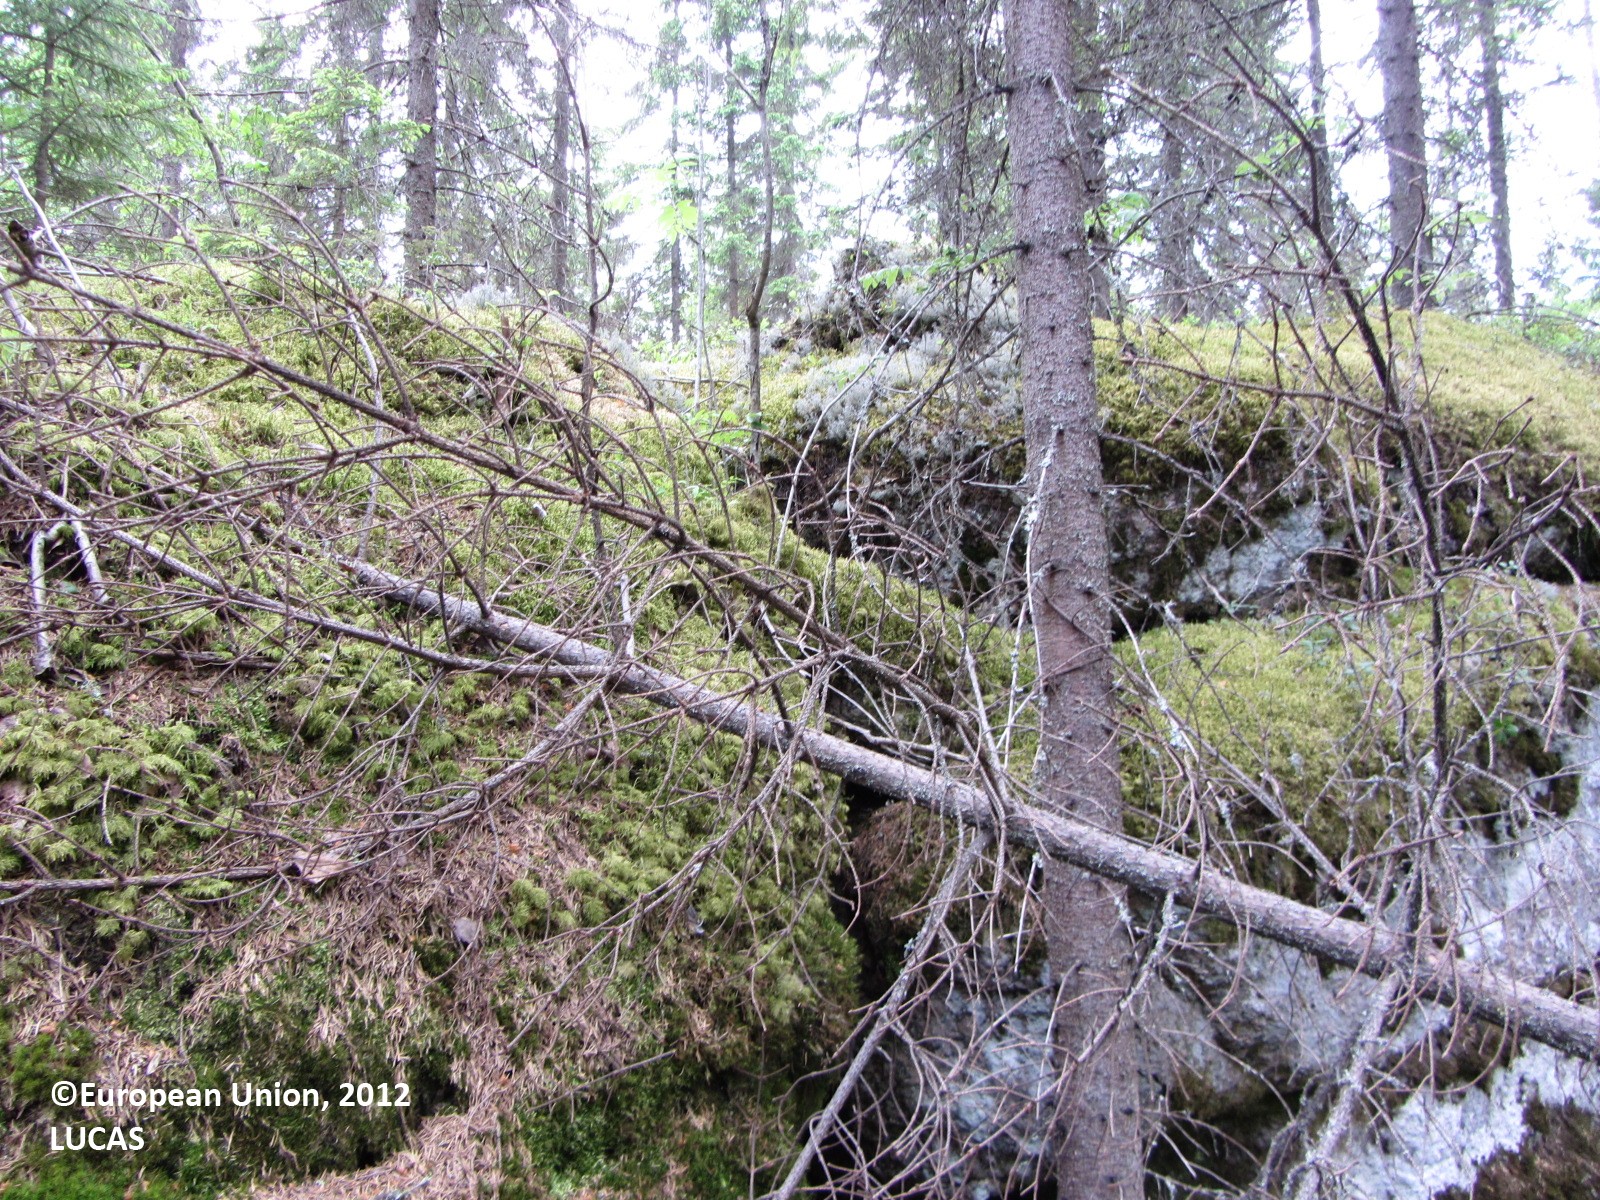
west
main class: Woodland
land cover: Spruce dominated coniferous woodland
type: boreal forest
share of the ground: 50 - 75 %
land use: Forestry
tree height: > 5 m
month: June
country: FI
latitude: 61.8761
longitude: 24.6072
